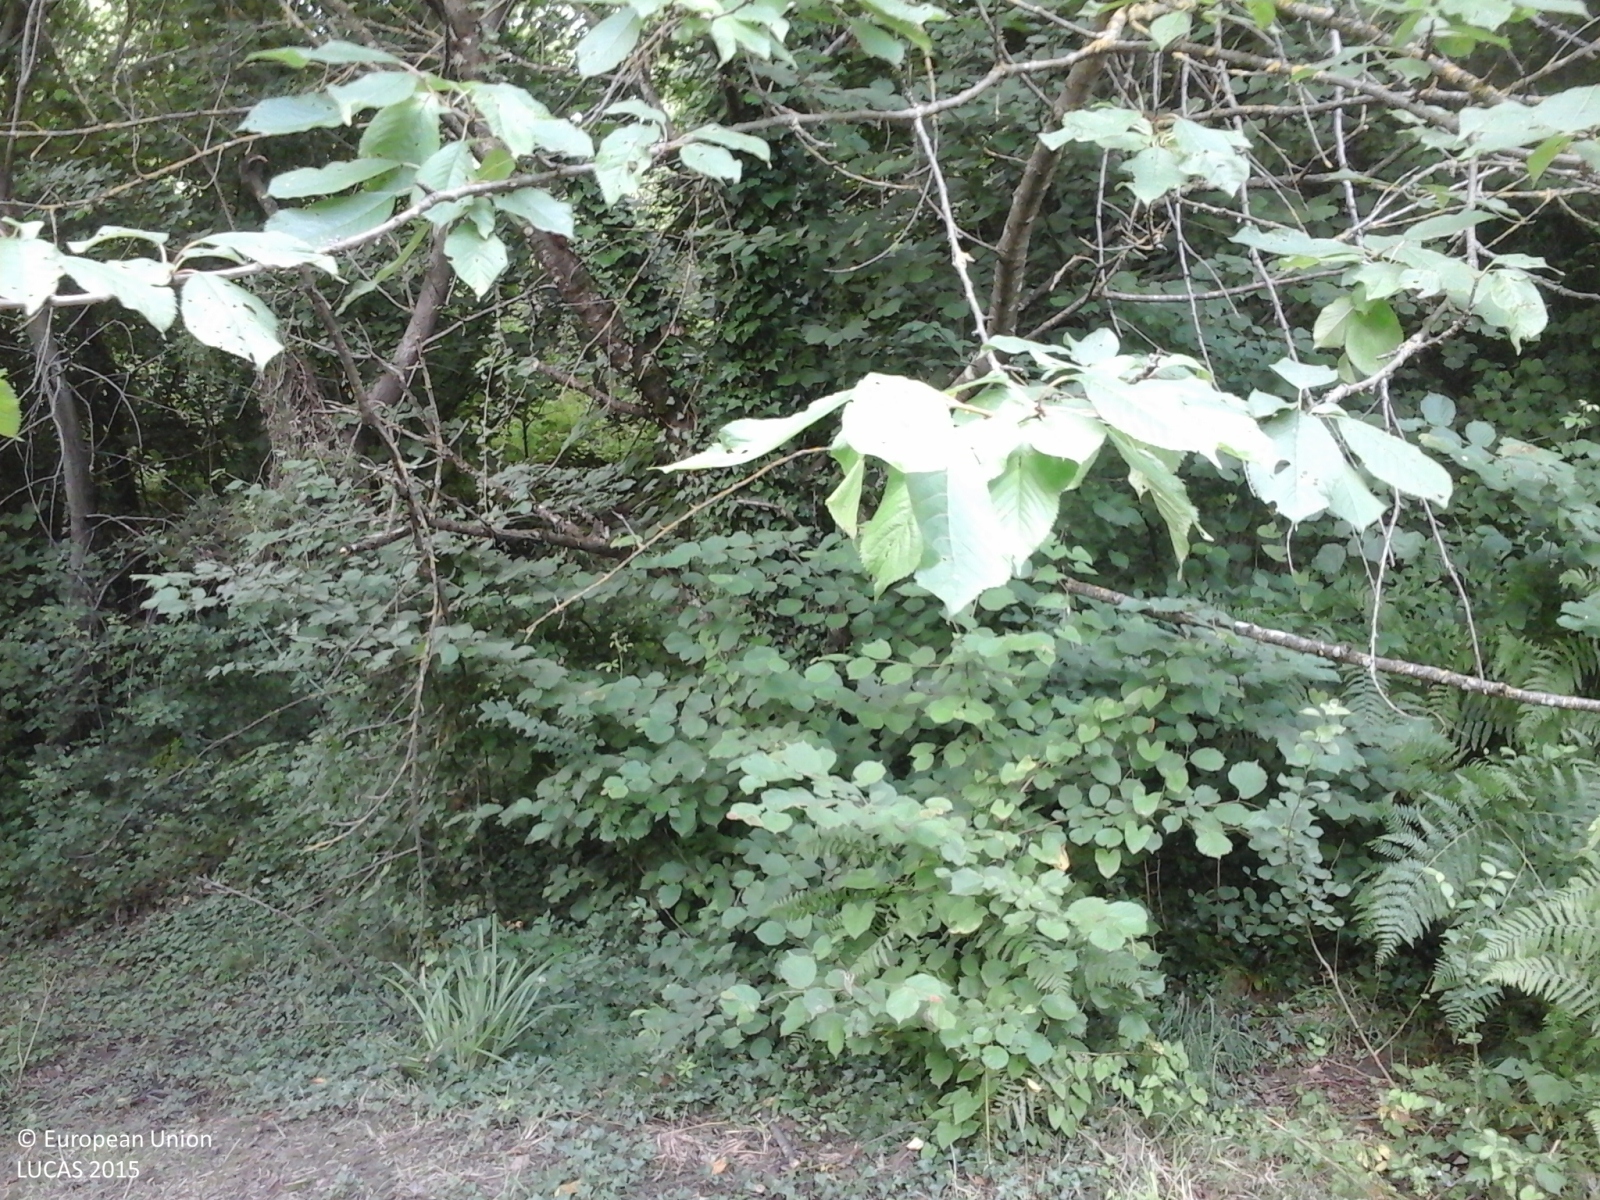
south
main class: Cropland
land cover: Nuts trees
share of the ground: > 75 %
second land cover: Grassland without tree/shrub cover
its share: 50 - 75 %
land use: Agriculture (excluding fallow land and kitchen gardens)
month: June
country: IT
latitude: 41.8124
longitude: 13.0582
